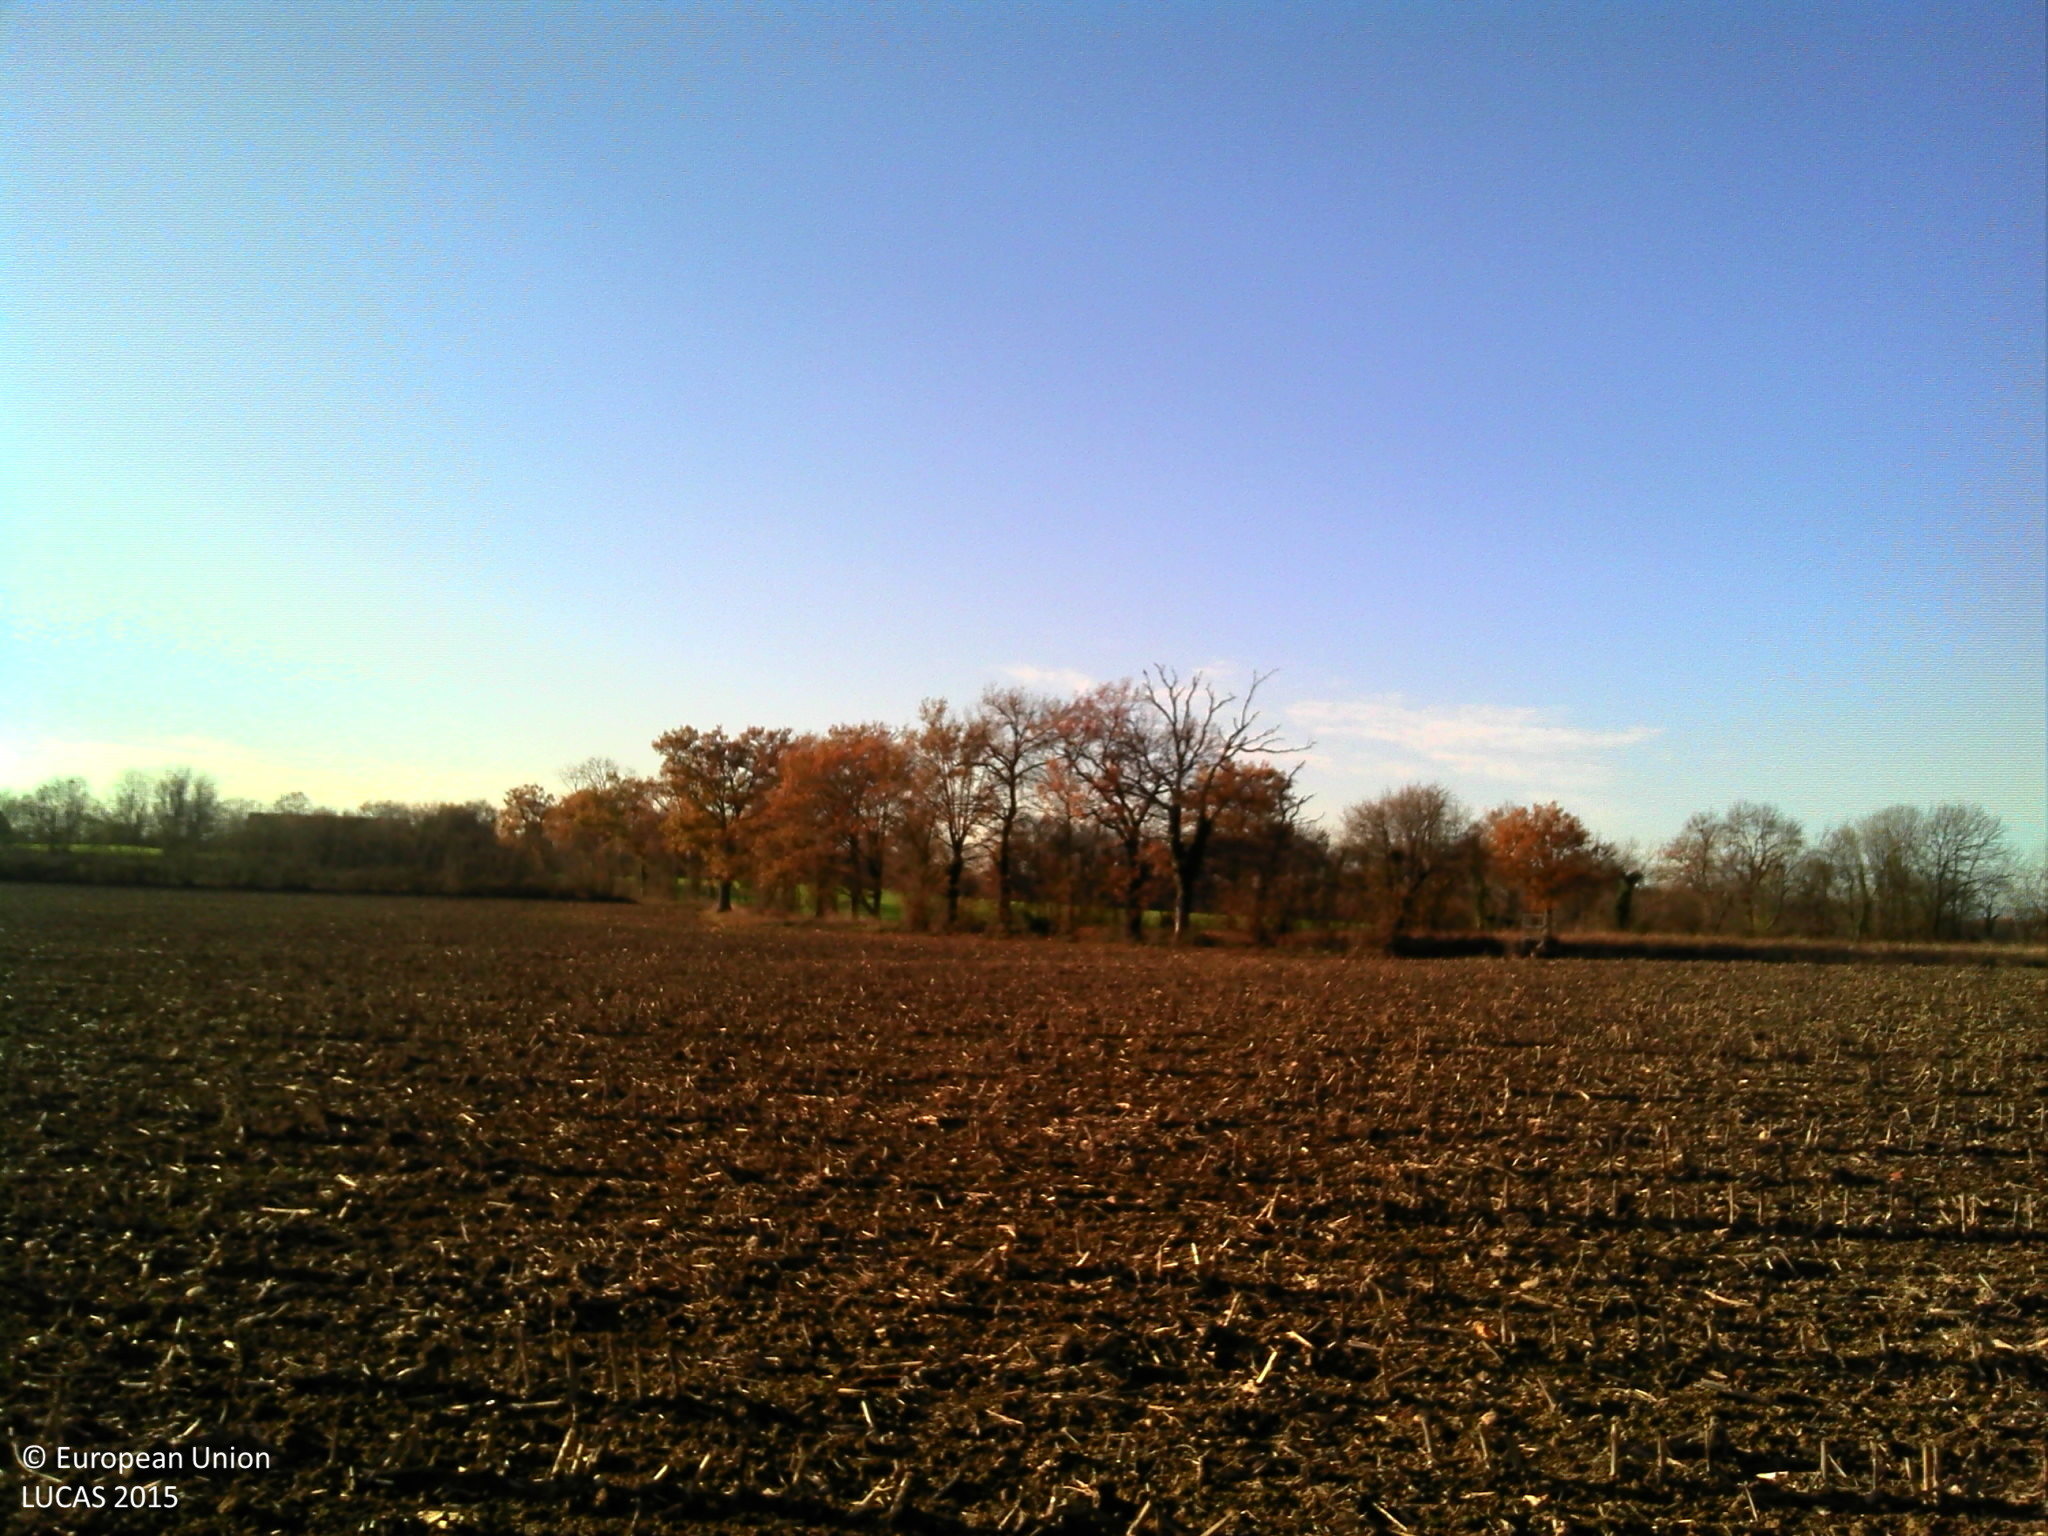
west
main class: Cropland
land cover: Maize
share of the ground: > 75 %
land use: Agriculture (excluding fallow land and kitchen gardens)
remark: Harvested field
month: December
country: FR
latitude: 46.0347
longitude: 4.9770
